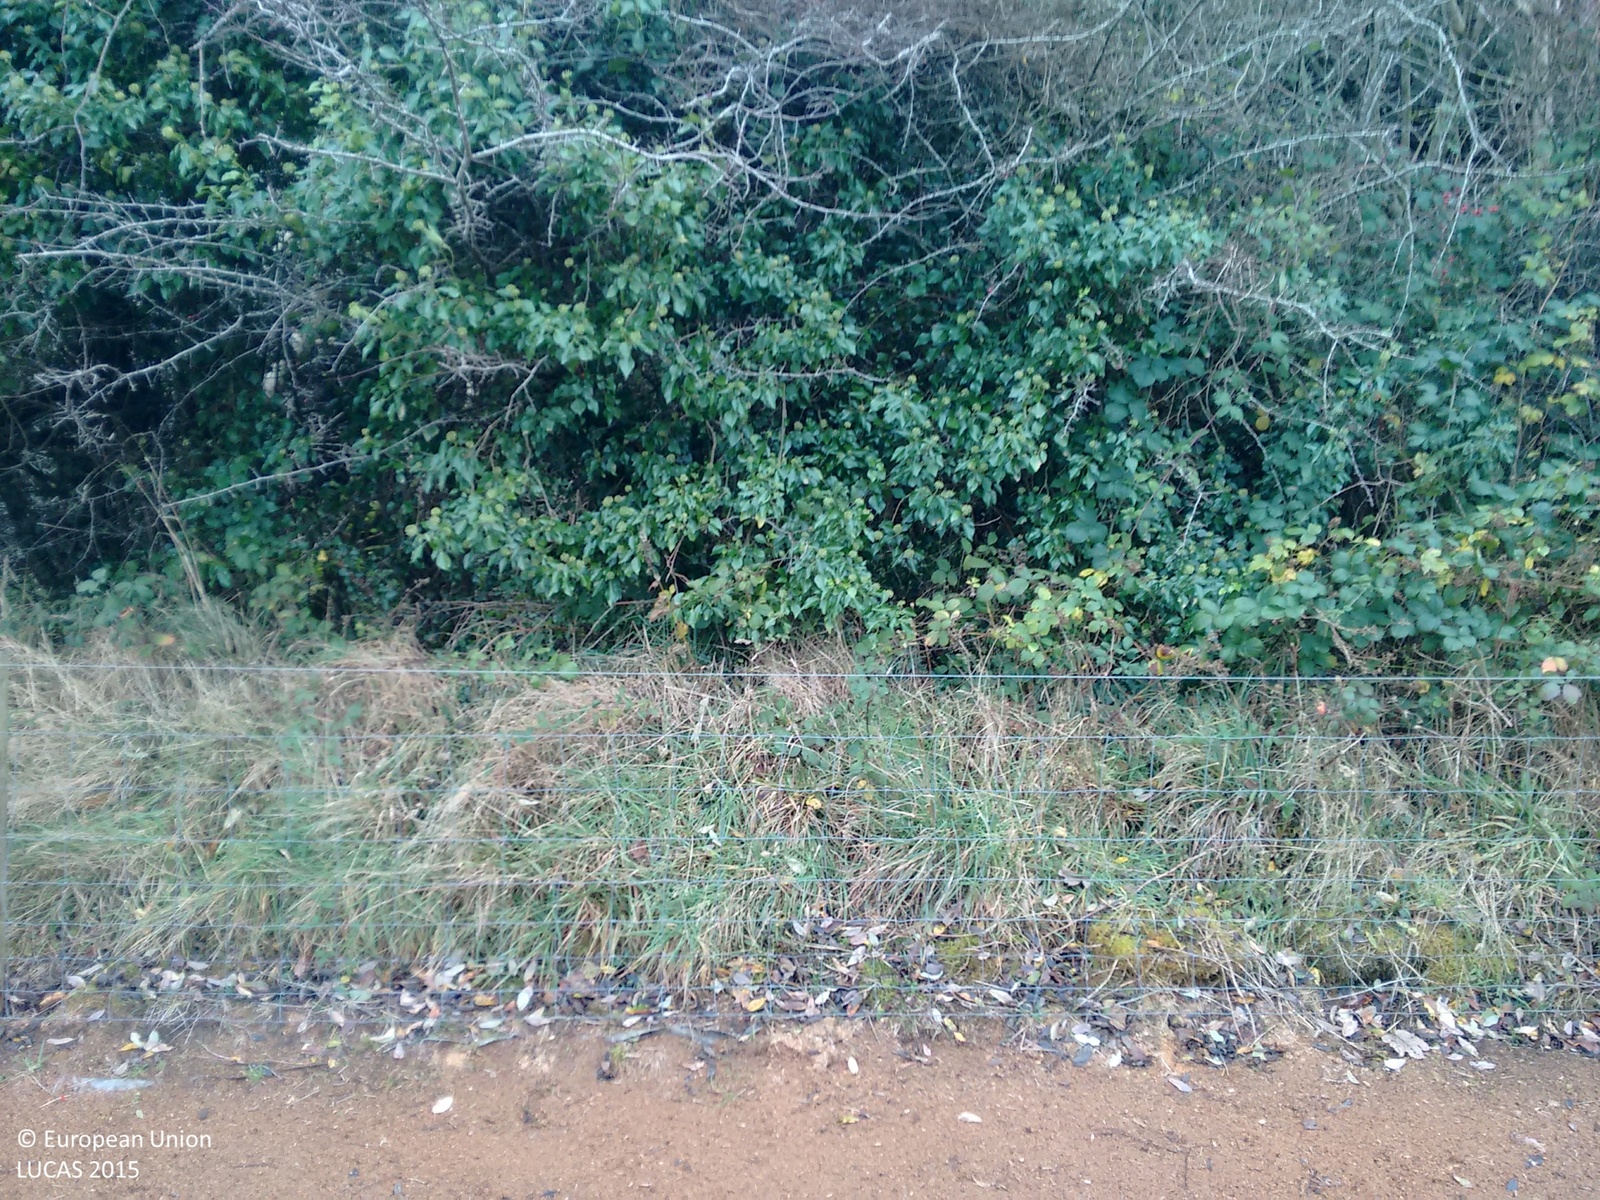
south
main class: Woodland
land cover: Broadleaved woodland
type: acidophilous oak and oak-birch forest
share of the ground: > 75 %
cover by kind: broadleaved forest trees 95 %, herbaceous plants 5 %
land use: Semi-natural and natural areas not in use
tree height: > 5 m
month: November
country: IE
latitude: 53.8191
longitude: -7.8031
